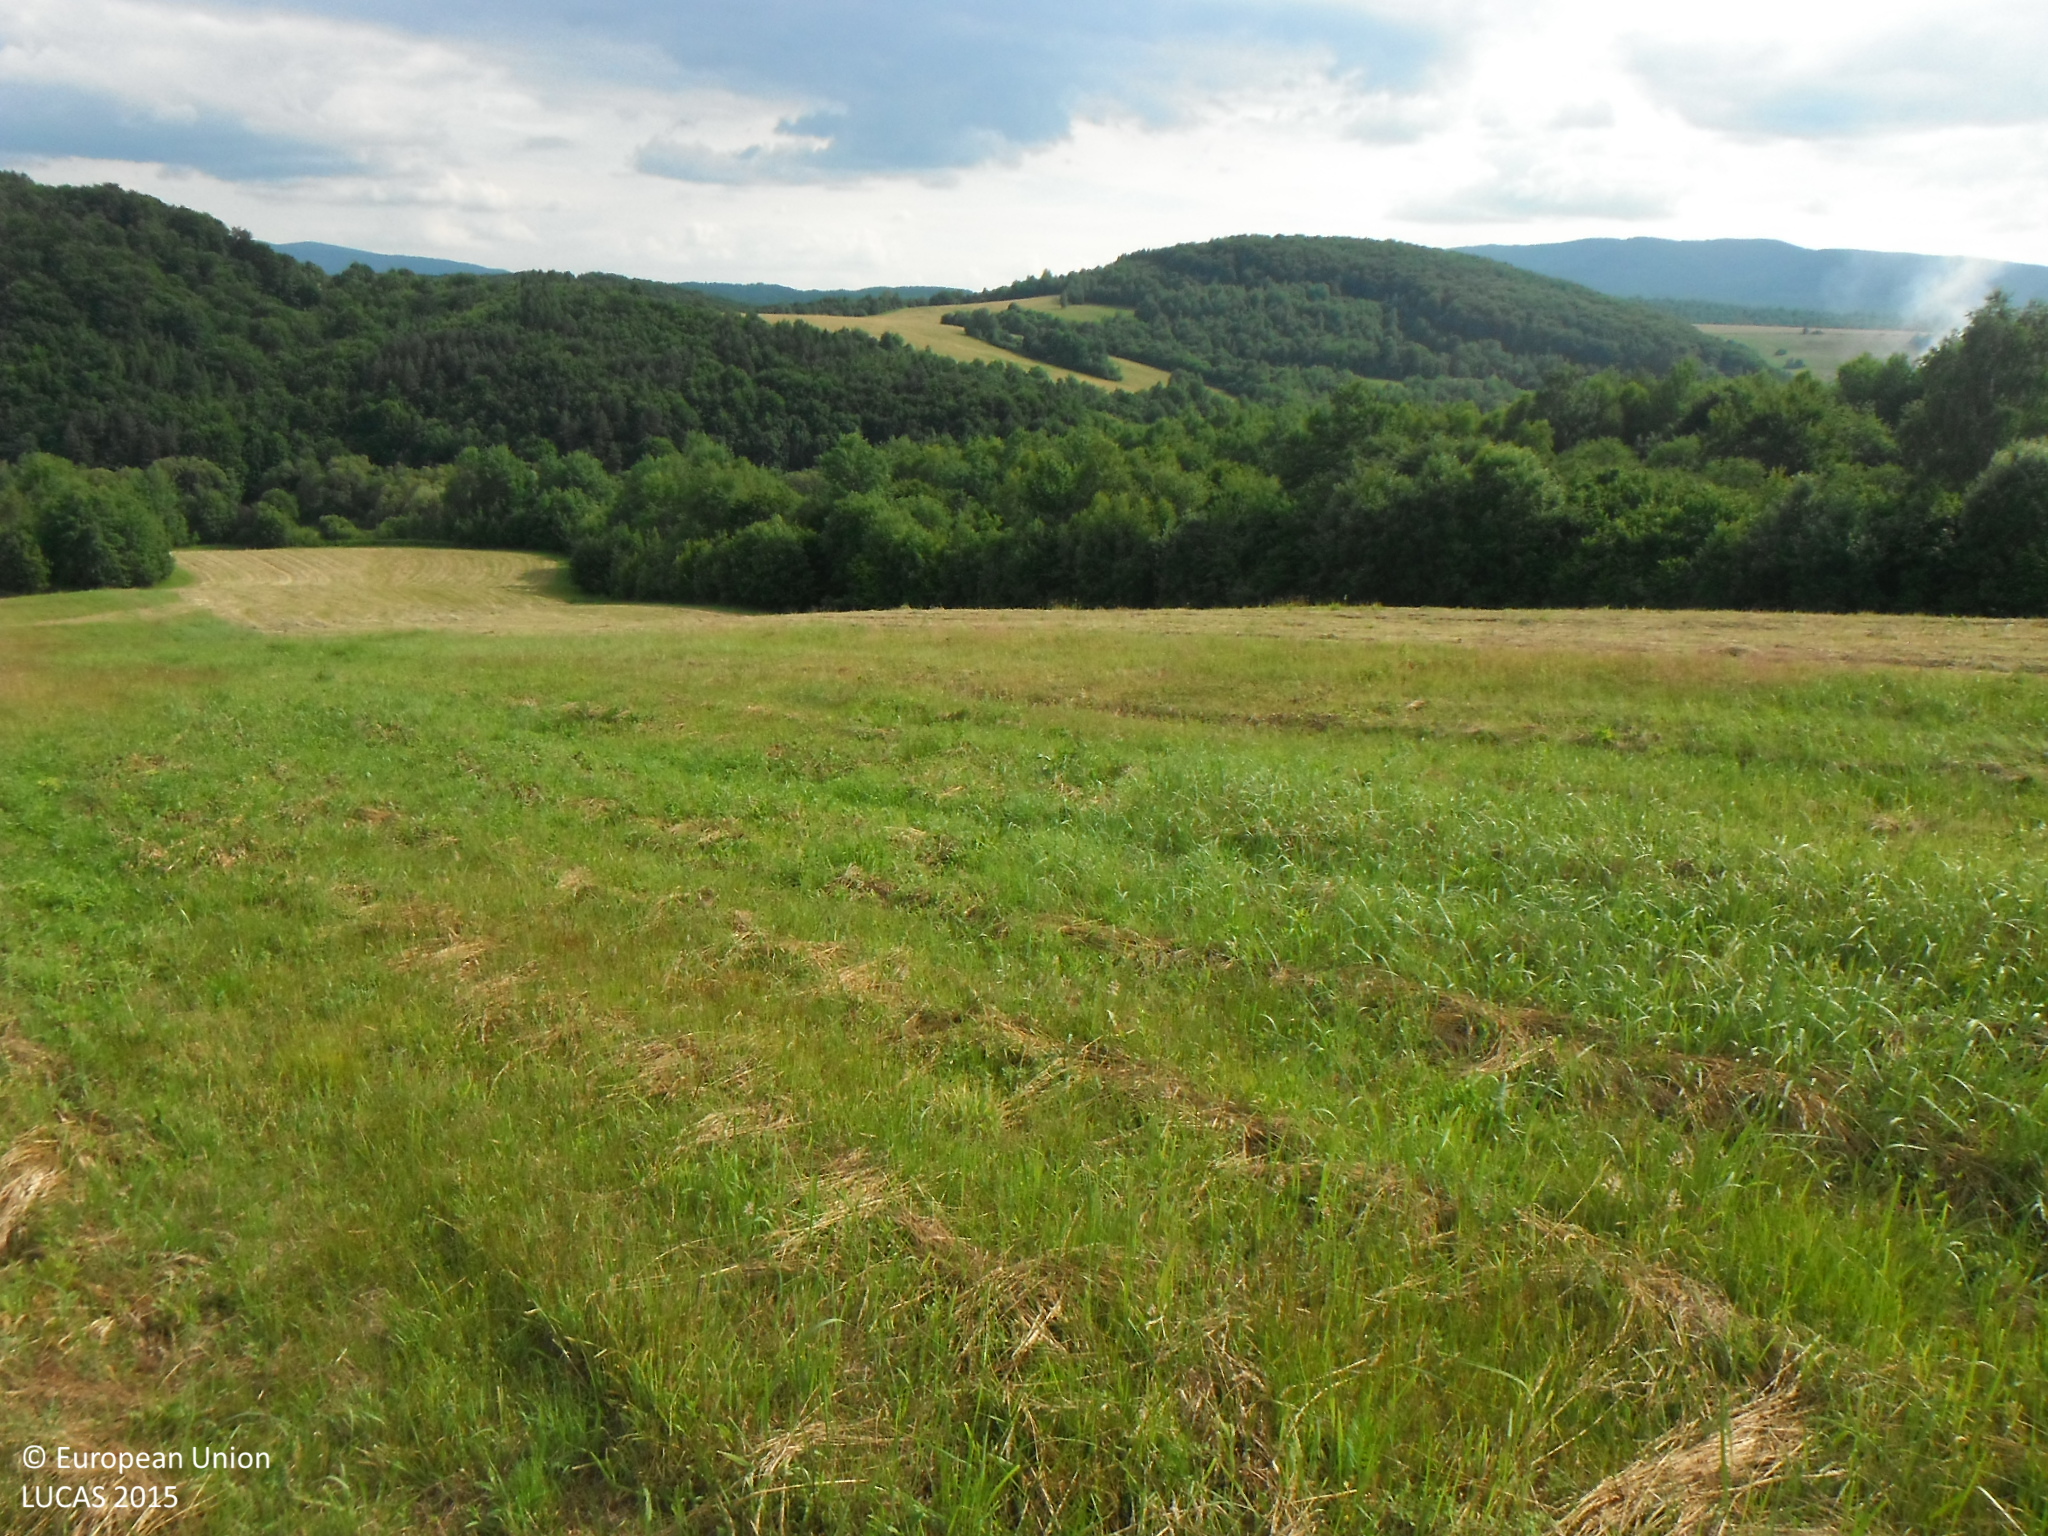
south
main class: Grassland
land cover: Grassland without tree/shrub cover
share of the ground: > 75 %
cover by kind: herbaceous plants 100 %
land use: Agriculture (excluding fallow land and kitchen gardens)
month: June
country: SK
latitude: 48.9295
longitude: 22.3313
